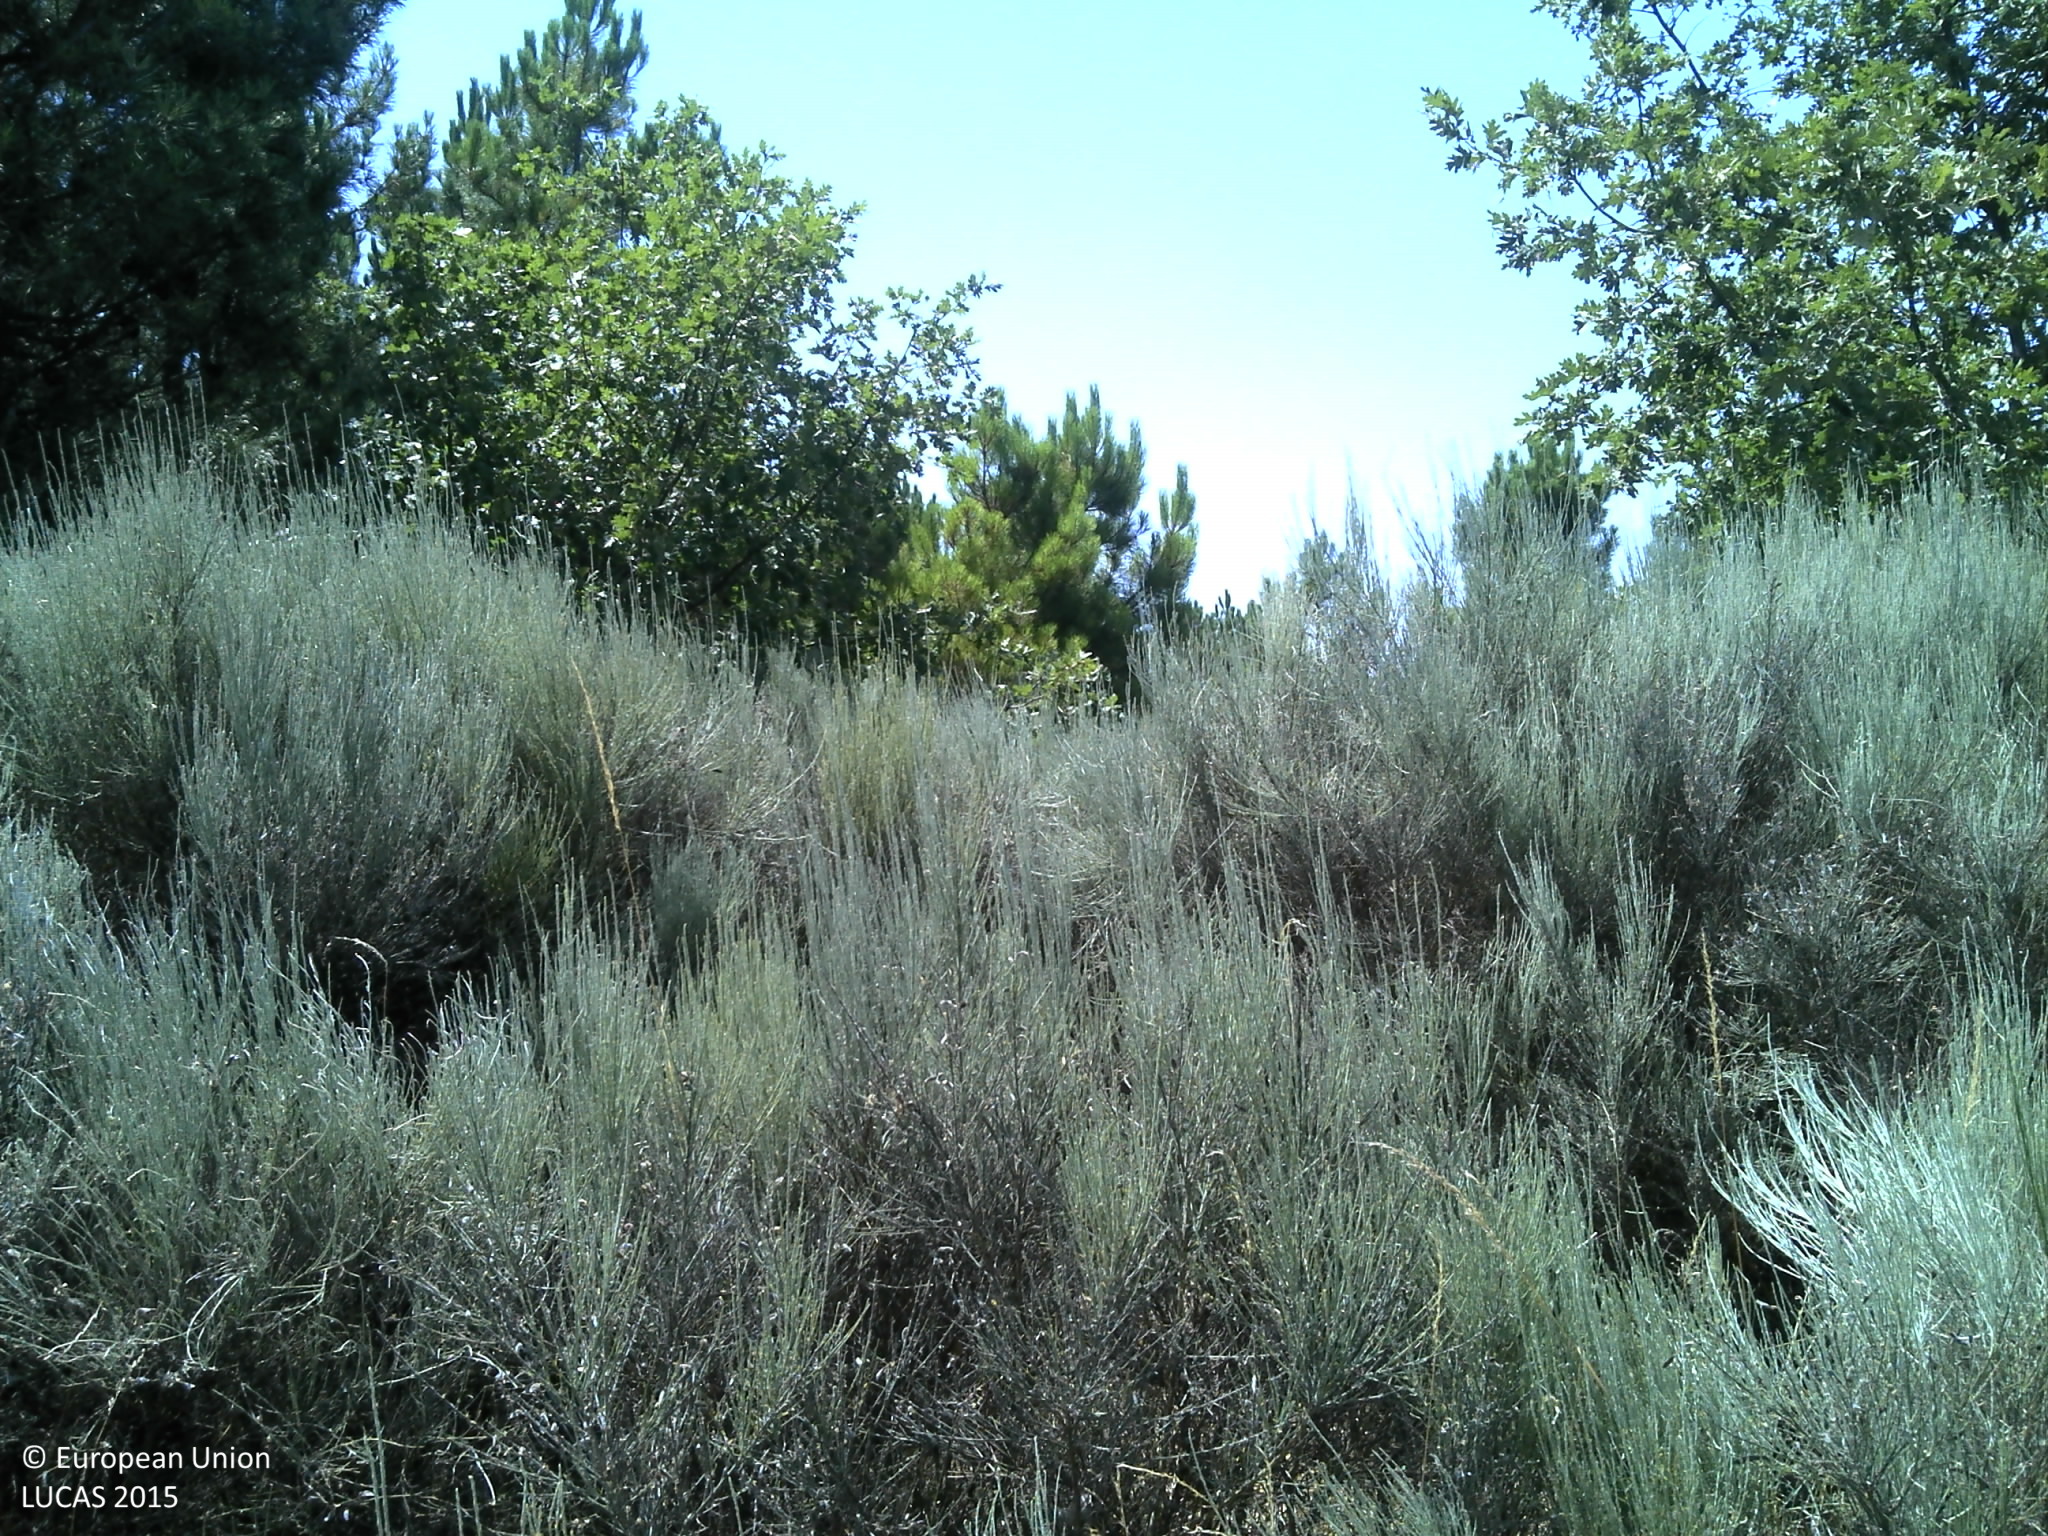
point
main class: Shrubland
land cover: Shrubland with sparse tree cover
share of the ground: > 75 %
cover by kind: shrubs 95 %, coniferous forest trees 5 %
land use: Abandoned areas
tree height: > 5 m
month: July
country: PT
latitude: 40.8310
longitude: -7.3426
